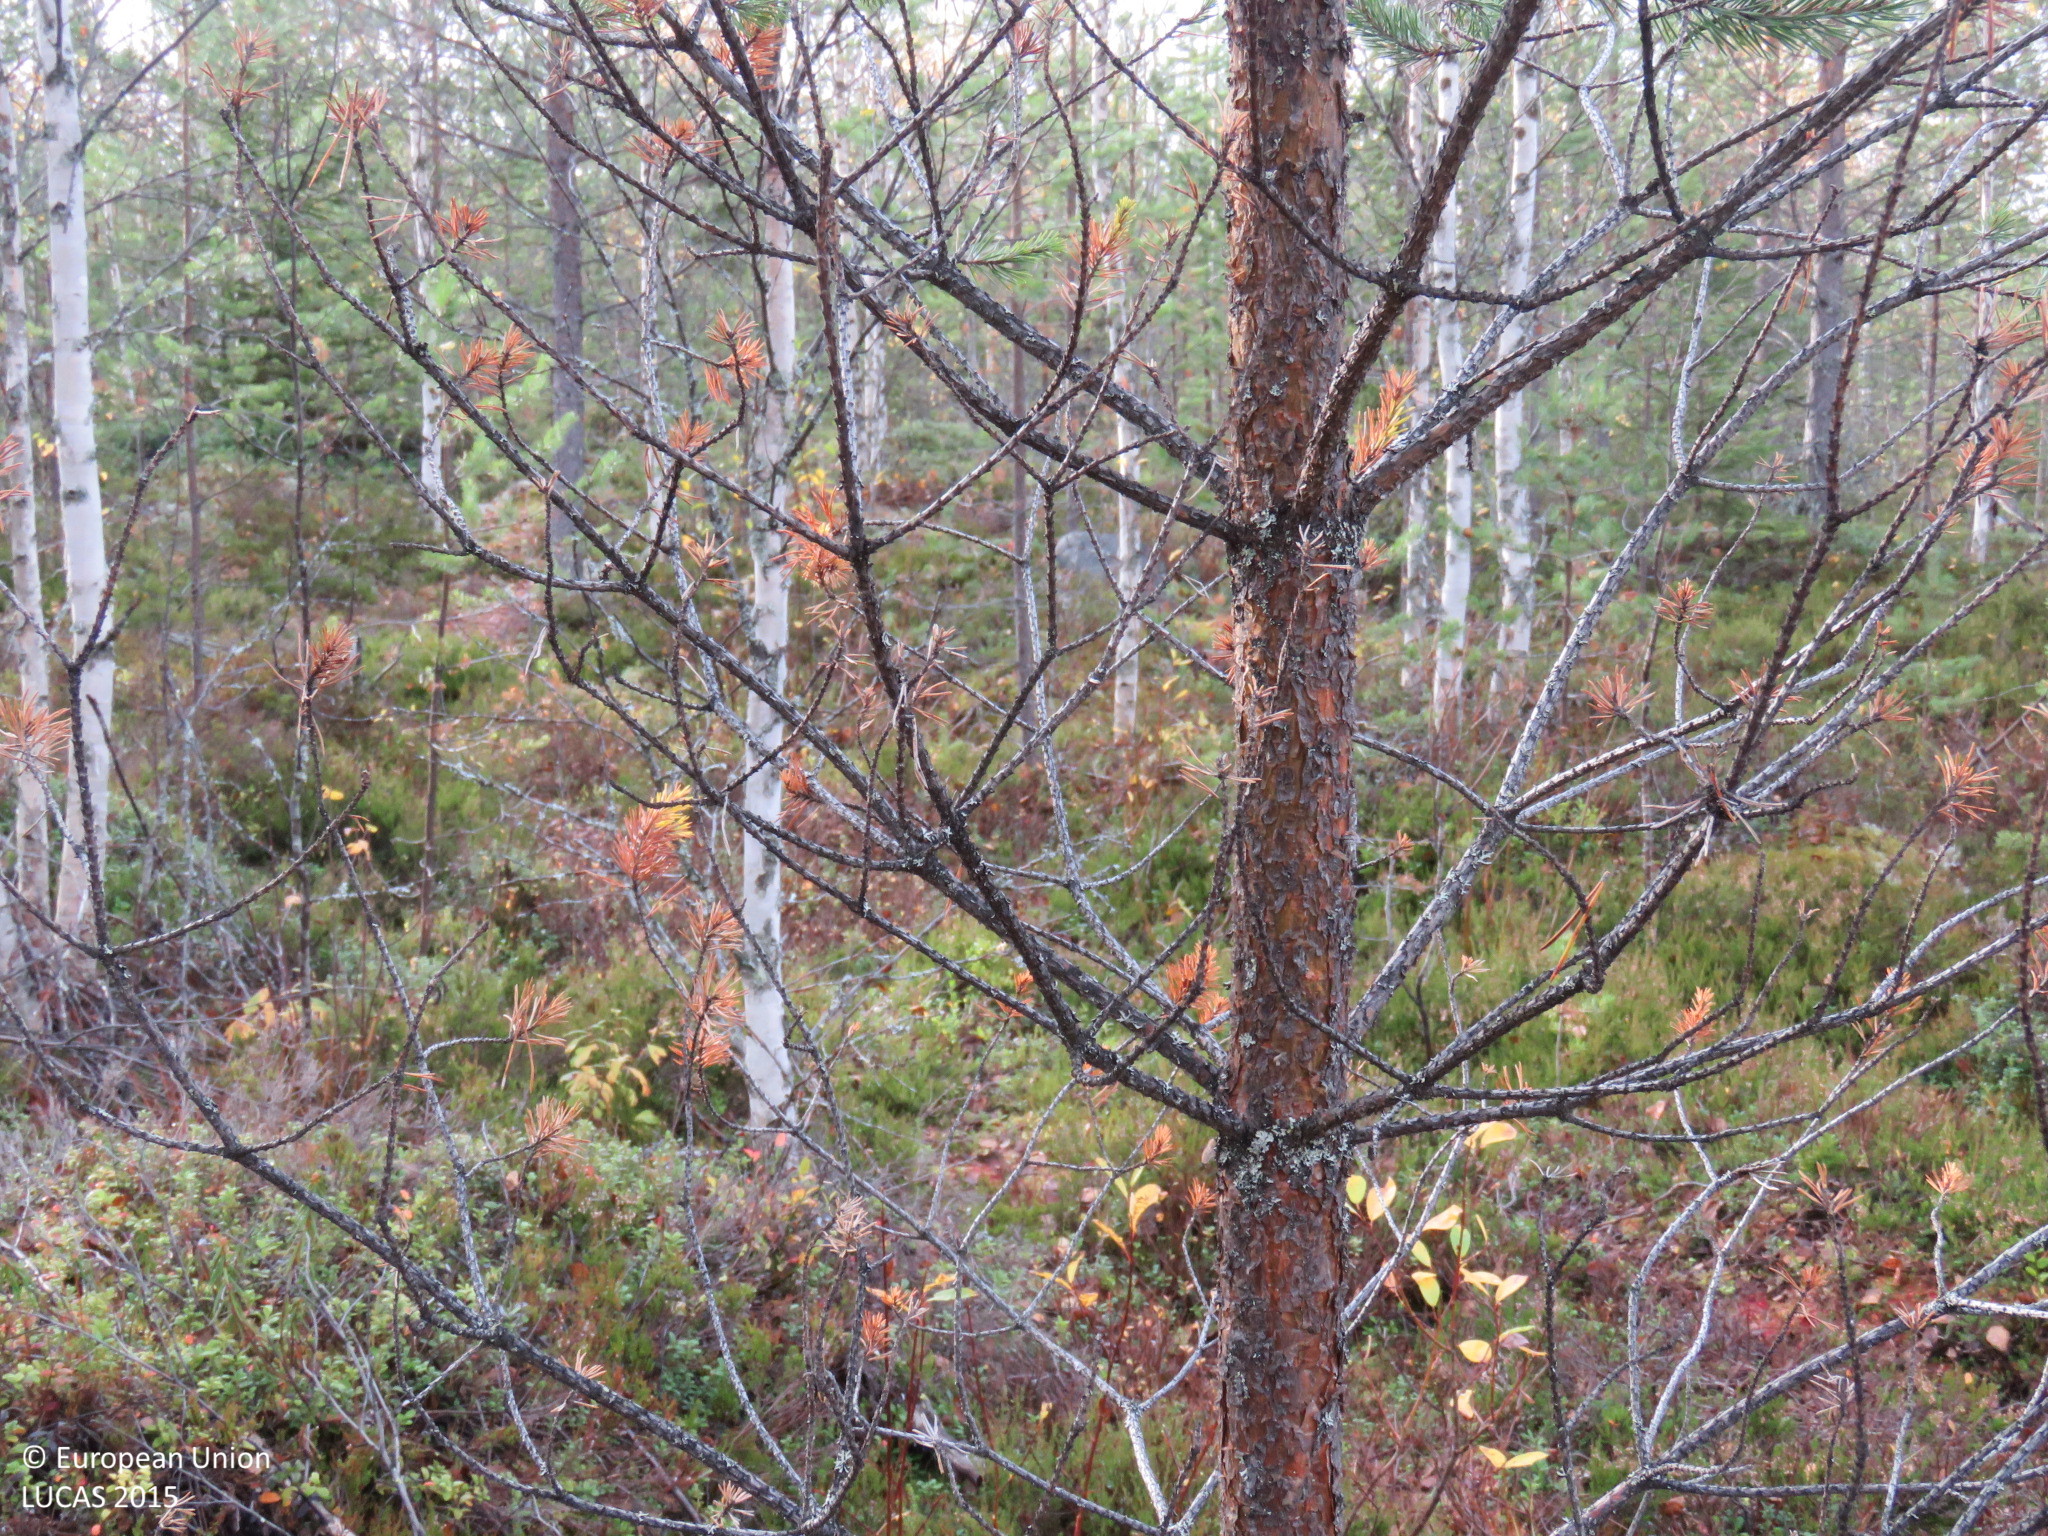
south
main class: Woodland
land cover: Other mixed woodland
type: boreal forest
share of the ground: > 75 %
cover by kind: coniferous forest trees 55 %, broadleaved forest trees 30 %, shrubs 10 %, lichens and mosses 5 %
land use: Forestry
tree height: > 5 m
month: September
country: FI
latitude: 64.9614
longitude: 27.1304
